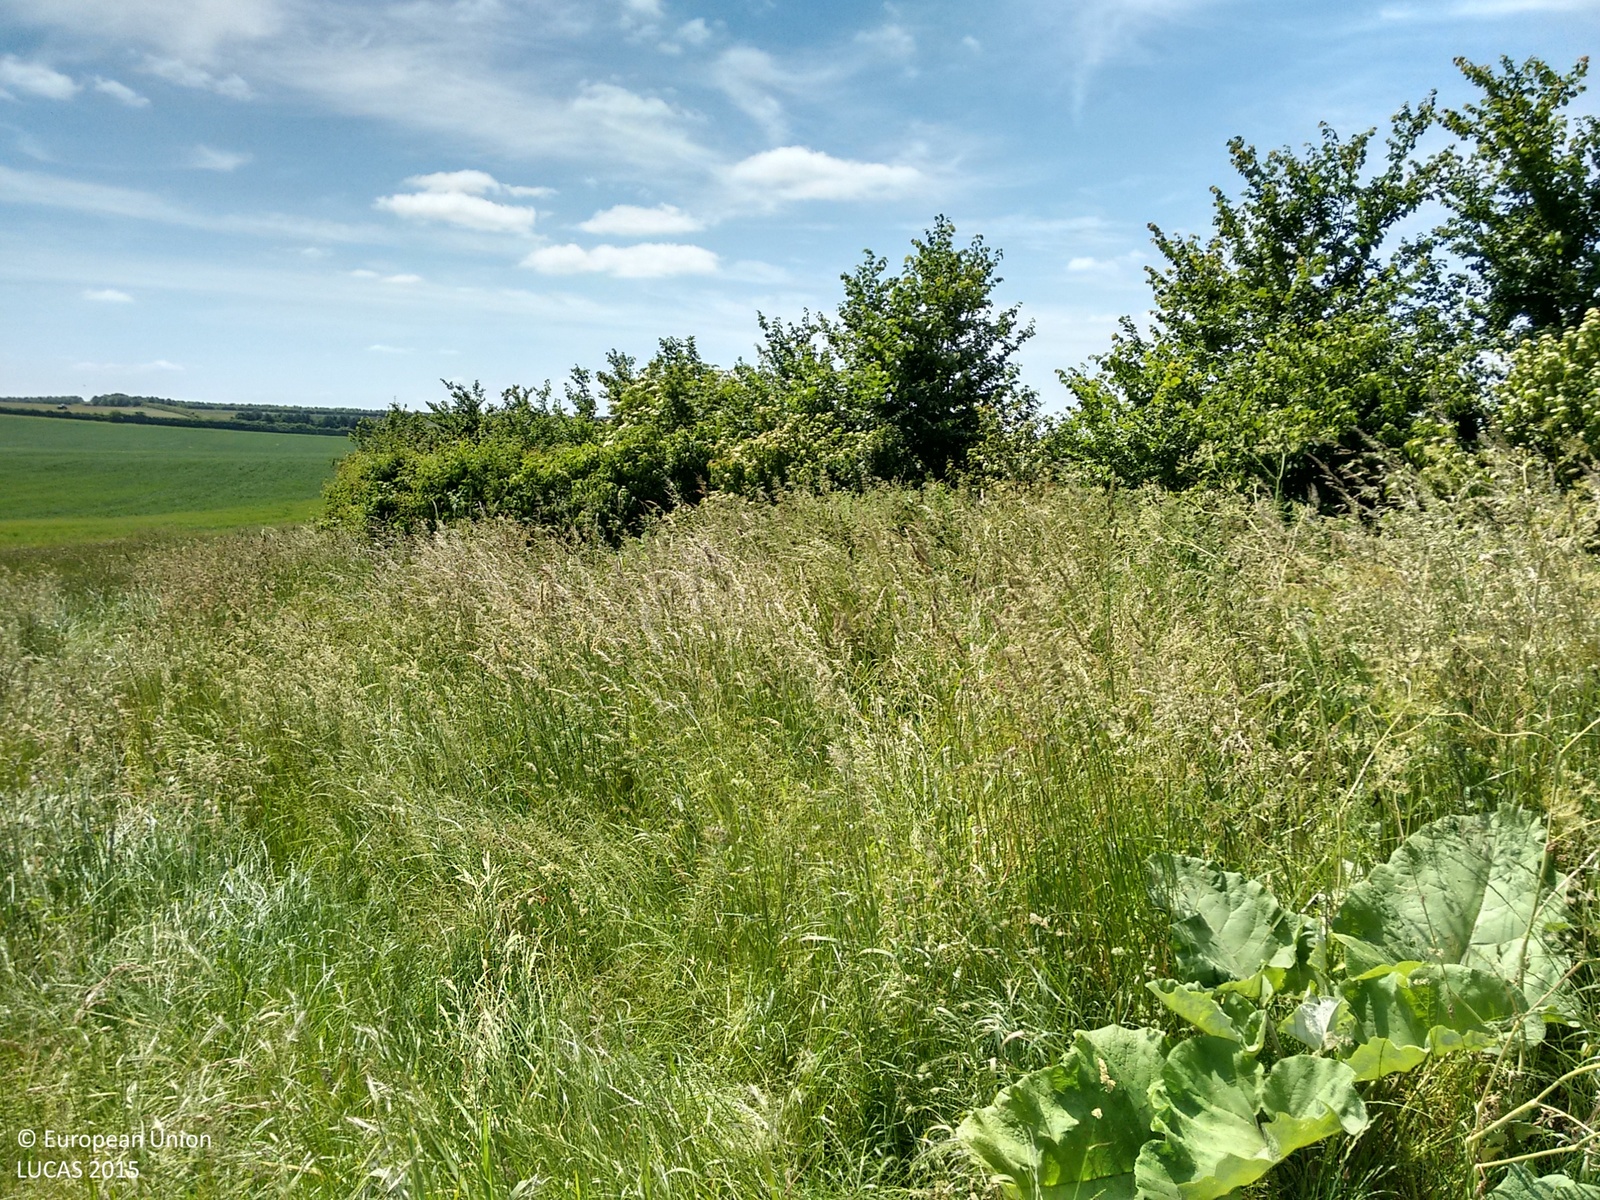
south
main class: Cropland
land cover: Barley
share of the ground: > 75 %
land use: Agriculture (excluding fallow land and kitchen gardens)
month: June
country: GB
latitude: 51.8923
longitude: -1.2805
